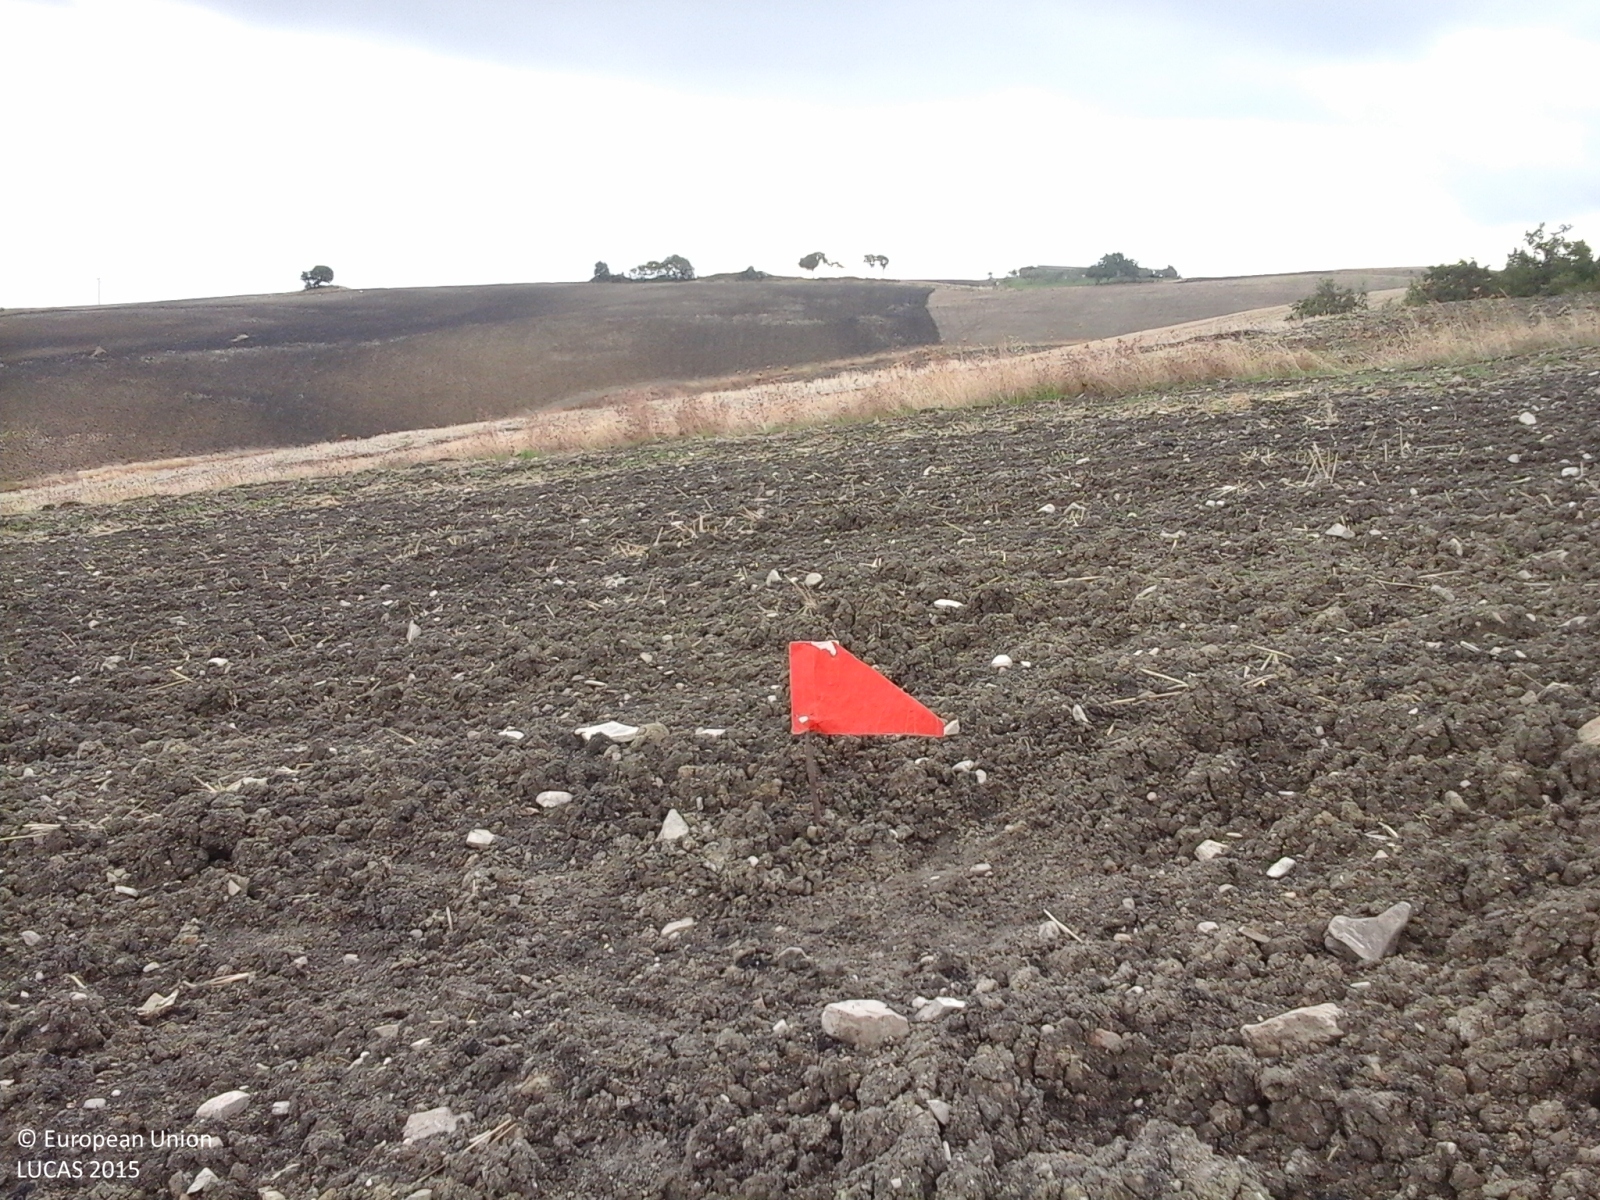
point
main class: Cropland
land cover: Durum wheat
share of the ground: > 75 %
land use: Agriculture (excluding fallow land and kitchen gardens)
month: October
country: IT
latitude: 41.4734
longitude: 15.1436
